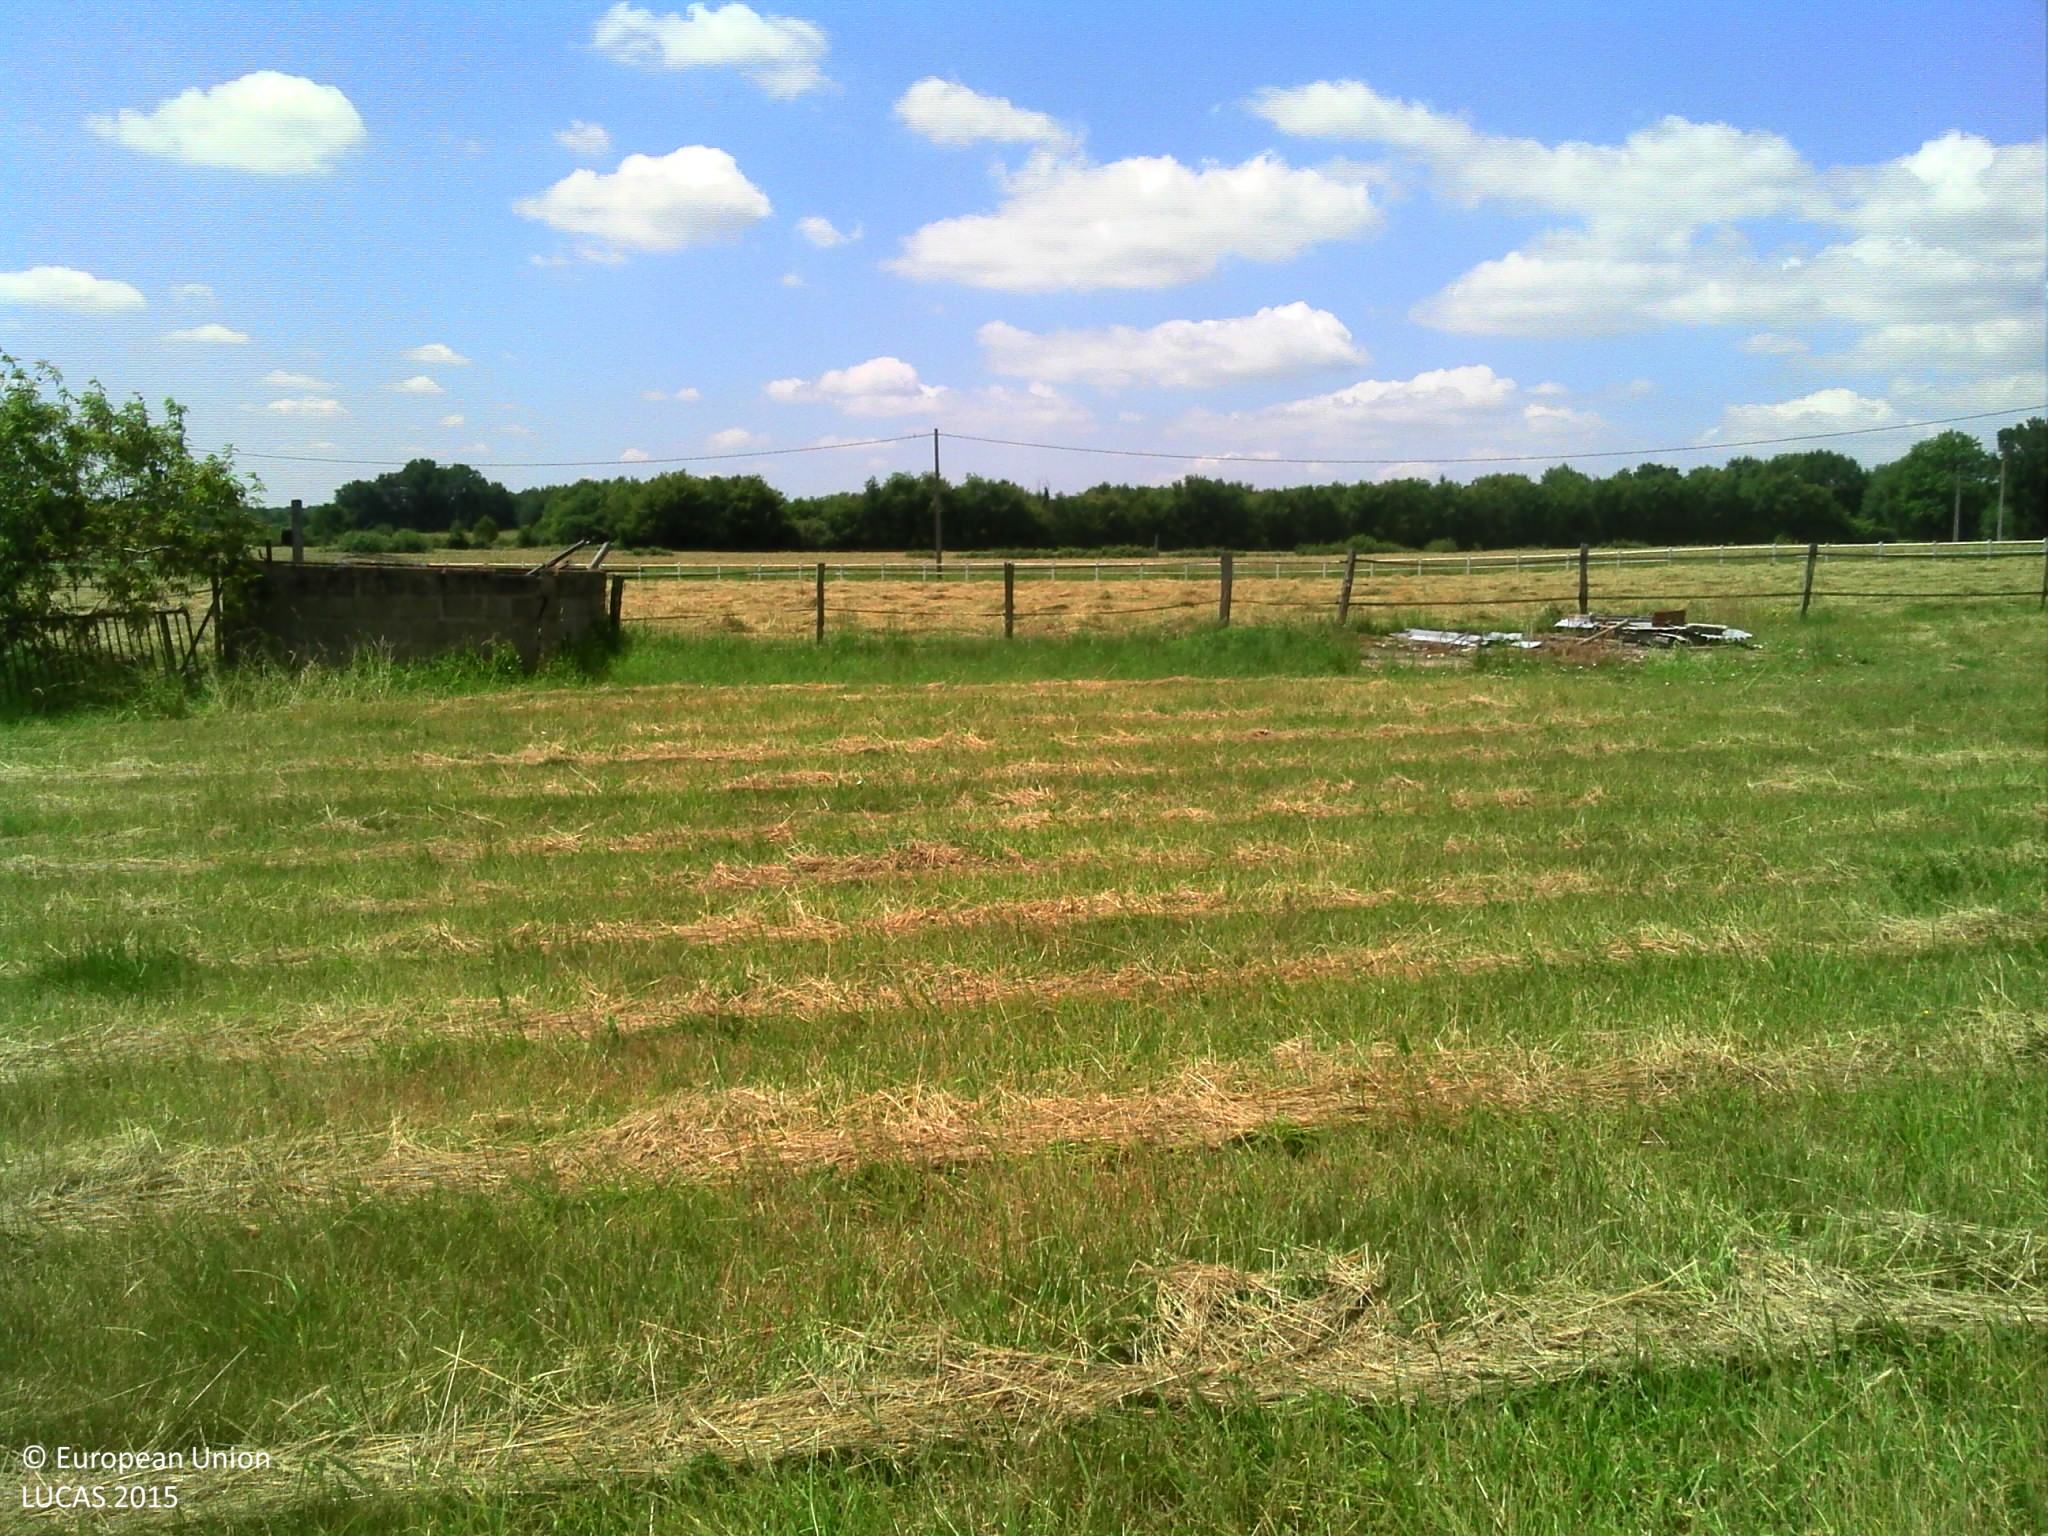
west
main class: Grassland
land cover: Grassland without tree/shrub cover
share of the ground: > 75 %
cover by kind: herbaceous plants 100 %
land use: Agriculture (excluding fallow land and kitchen gardens)
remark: Harvested field
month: June
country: FR
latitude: 47.4319
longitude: 0.4992
